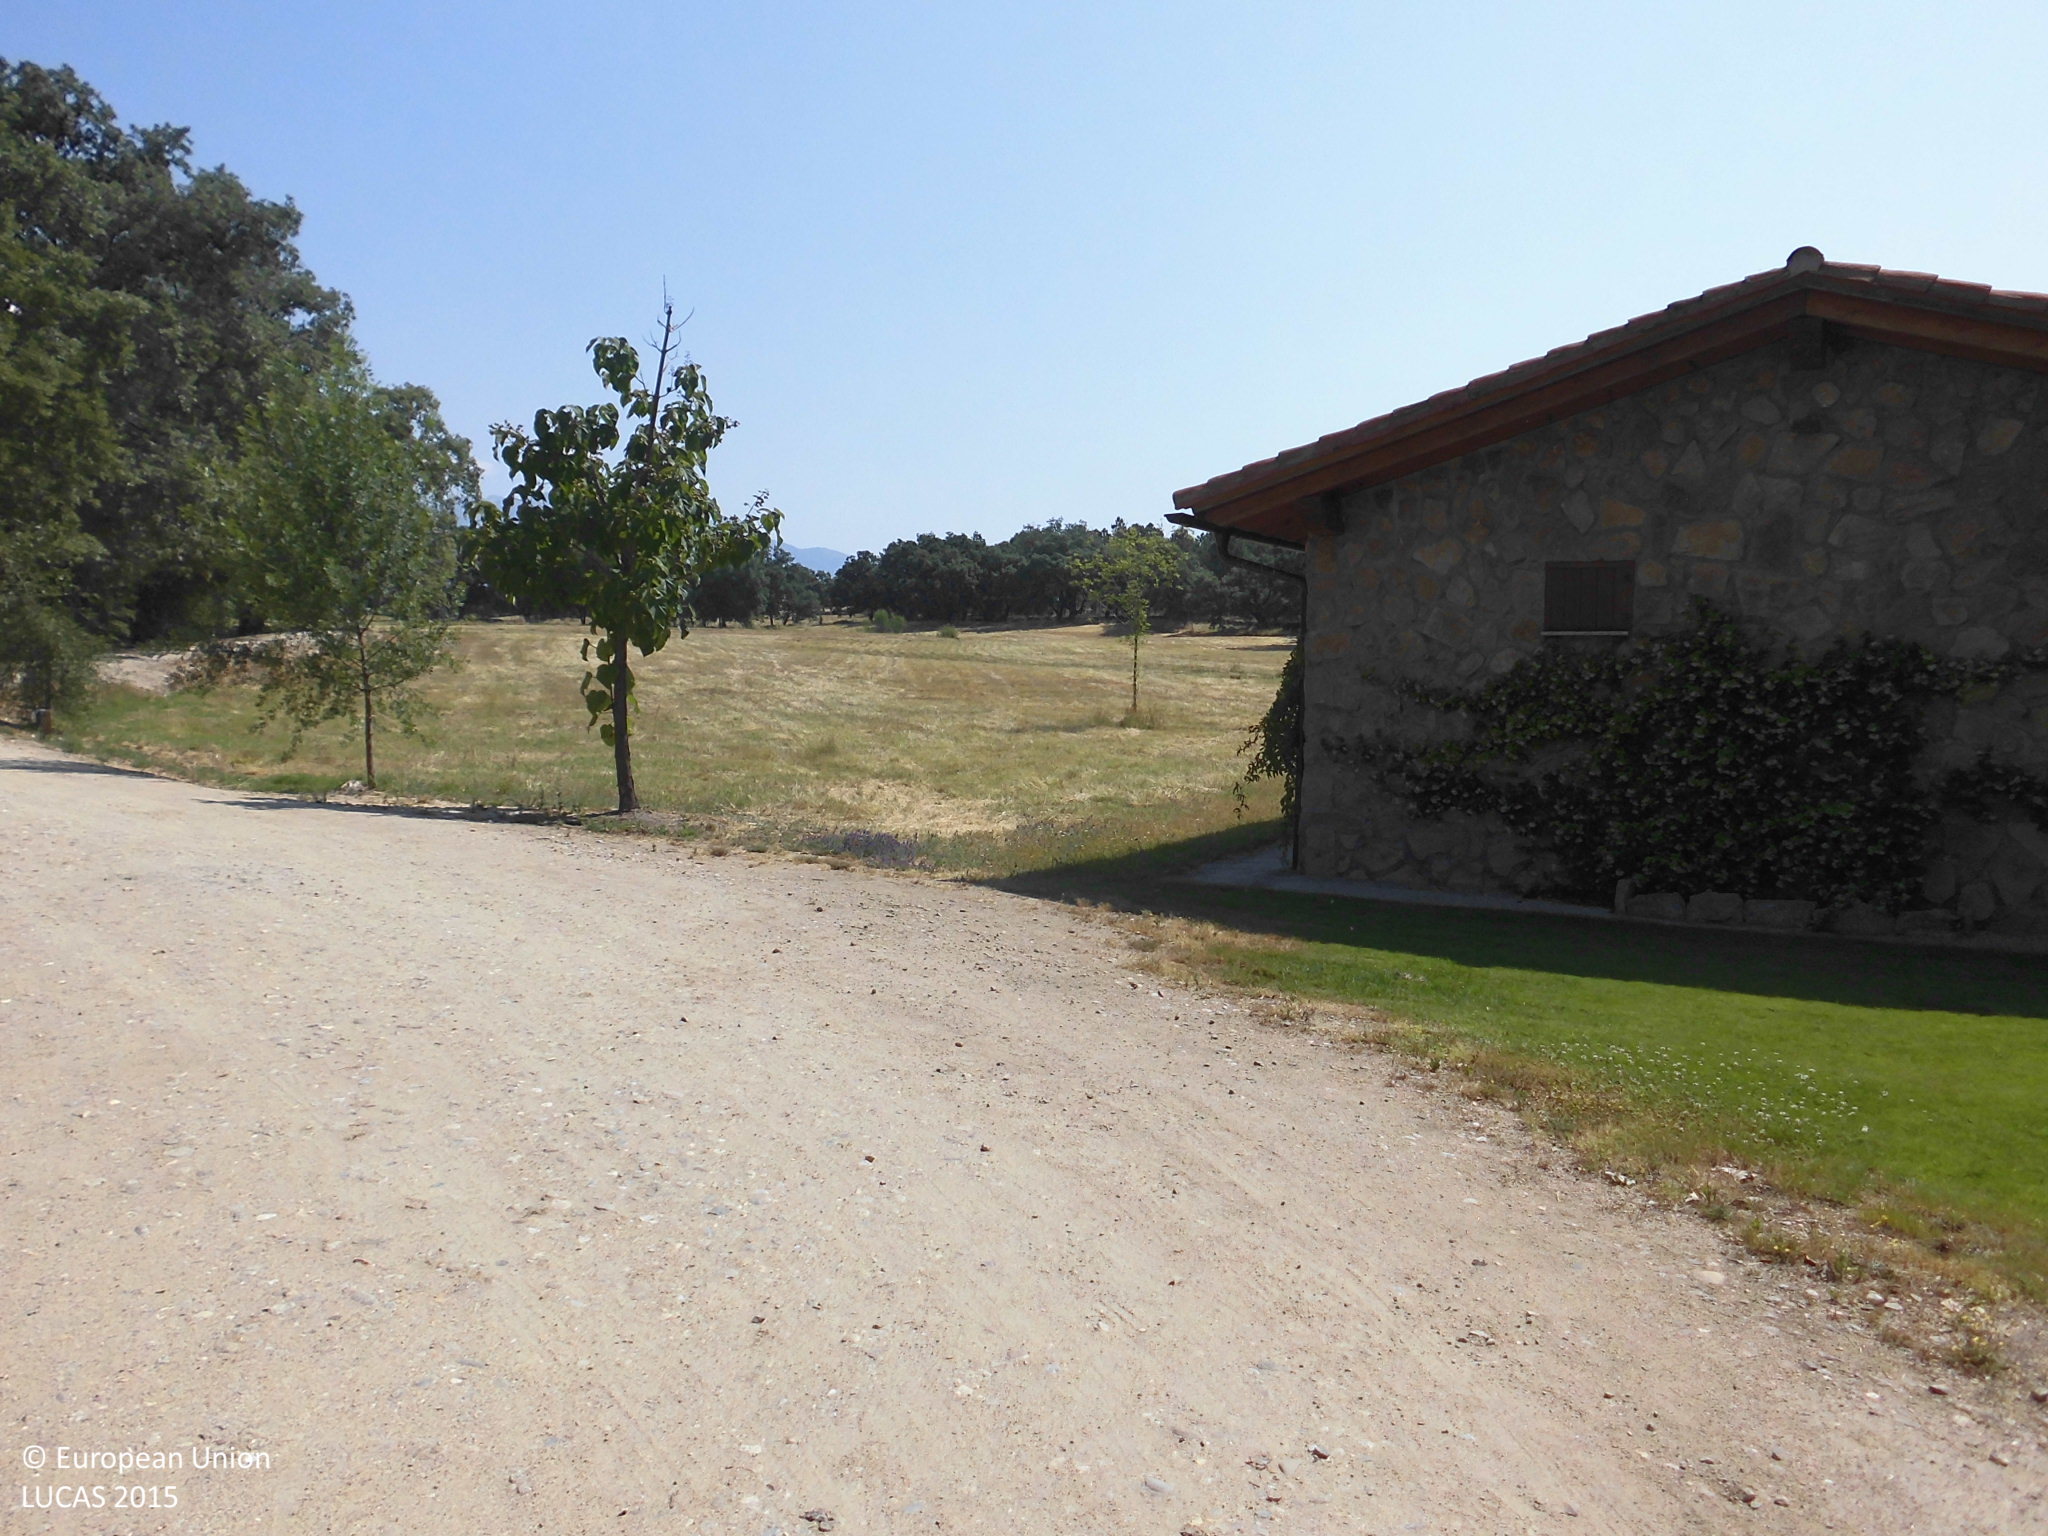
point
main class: Shrubland
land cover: Shrubland with sparse tree cover
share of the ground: 25 - 50 %
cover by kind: herbaceous plants 50 %, shrubs 45 %, broadleaved forest trees 5 %
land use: Agriculture (excluding fallow land and kitchen gardens)
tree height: > 5 m
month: June
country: ES
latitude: 40.1029
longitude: -5.4395
